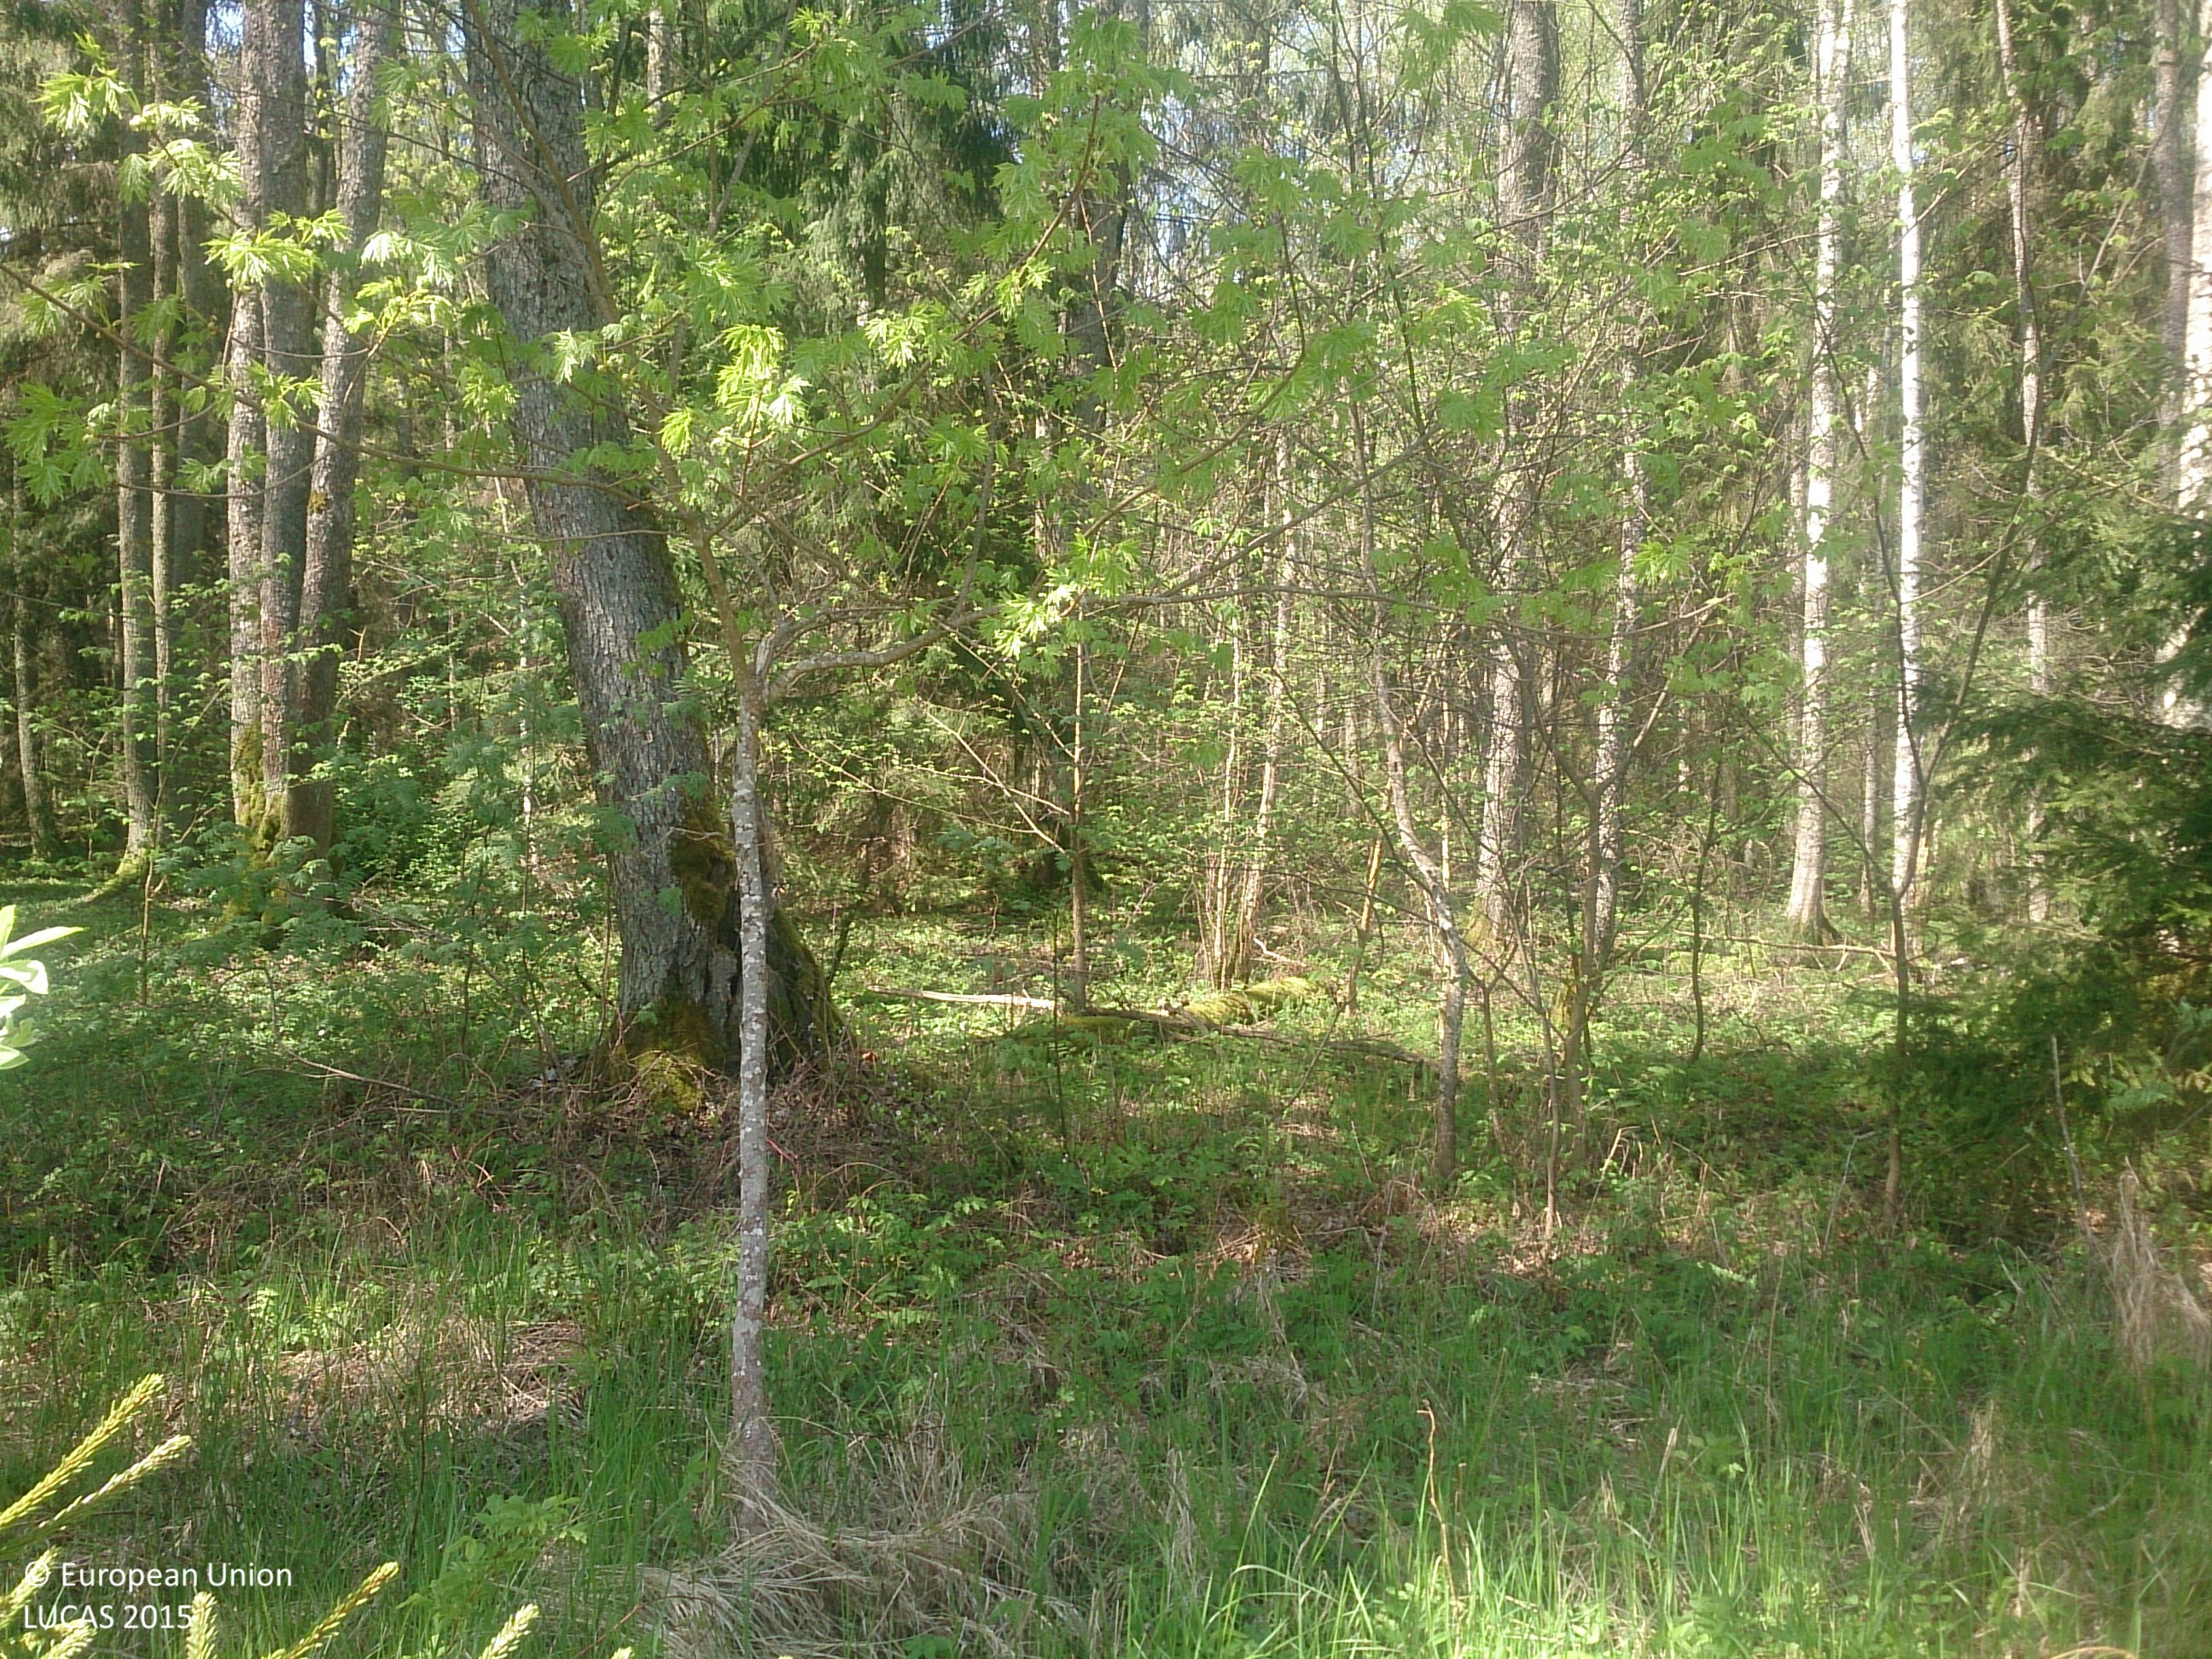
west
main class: Woodland
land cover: Spruce dominated mixed woodland
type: hemiboreal forest and nemoral coniferous forest and mixed broadleaved-coniferous forest
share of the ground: 25 - 50 %
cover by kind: herbaceous plants 50 %, broadleaved forest trees 25 %, coniferous forest trees 20 %, shrubs 5 %
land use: Forestry
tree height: < 5 m
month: May
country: LV
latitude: 56.7709
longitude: 24.1420
